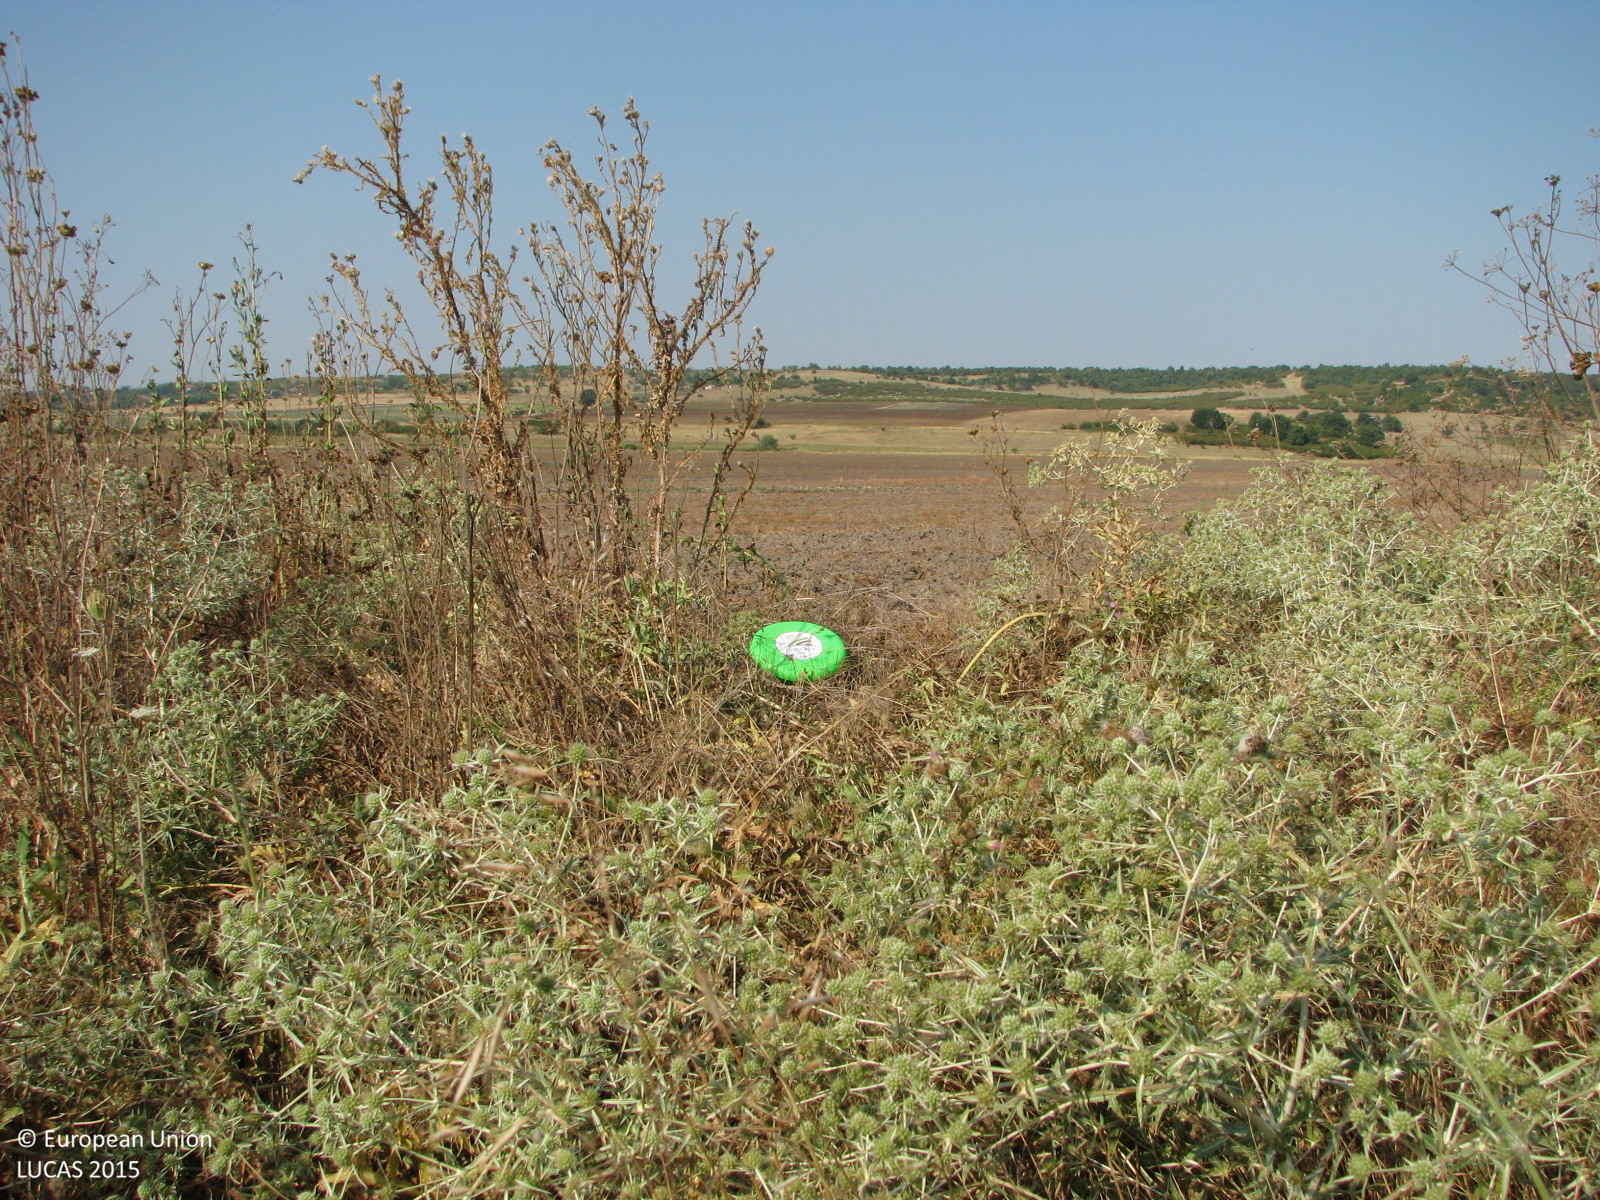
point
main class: Grassland
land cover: Spontaneously vegetated surfaces
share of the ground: > 75 %
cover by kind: herbaceous plants 100 %
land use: Semi-natural and natural areas not in use
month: August
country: BG
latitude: 42.1839
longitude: 26.5436
